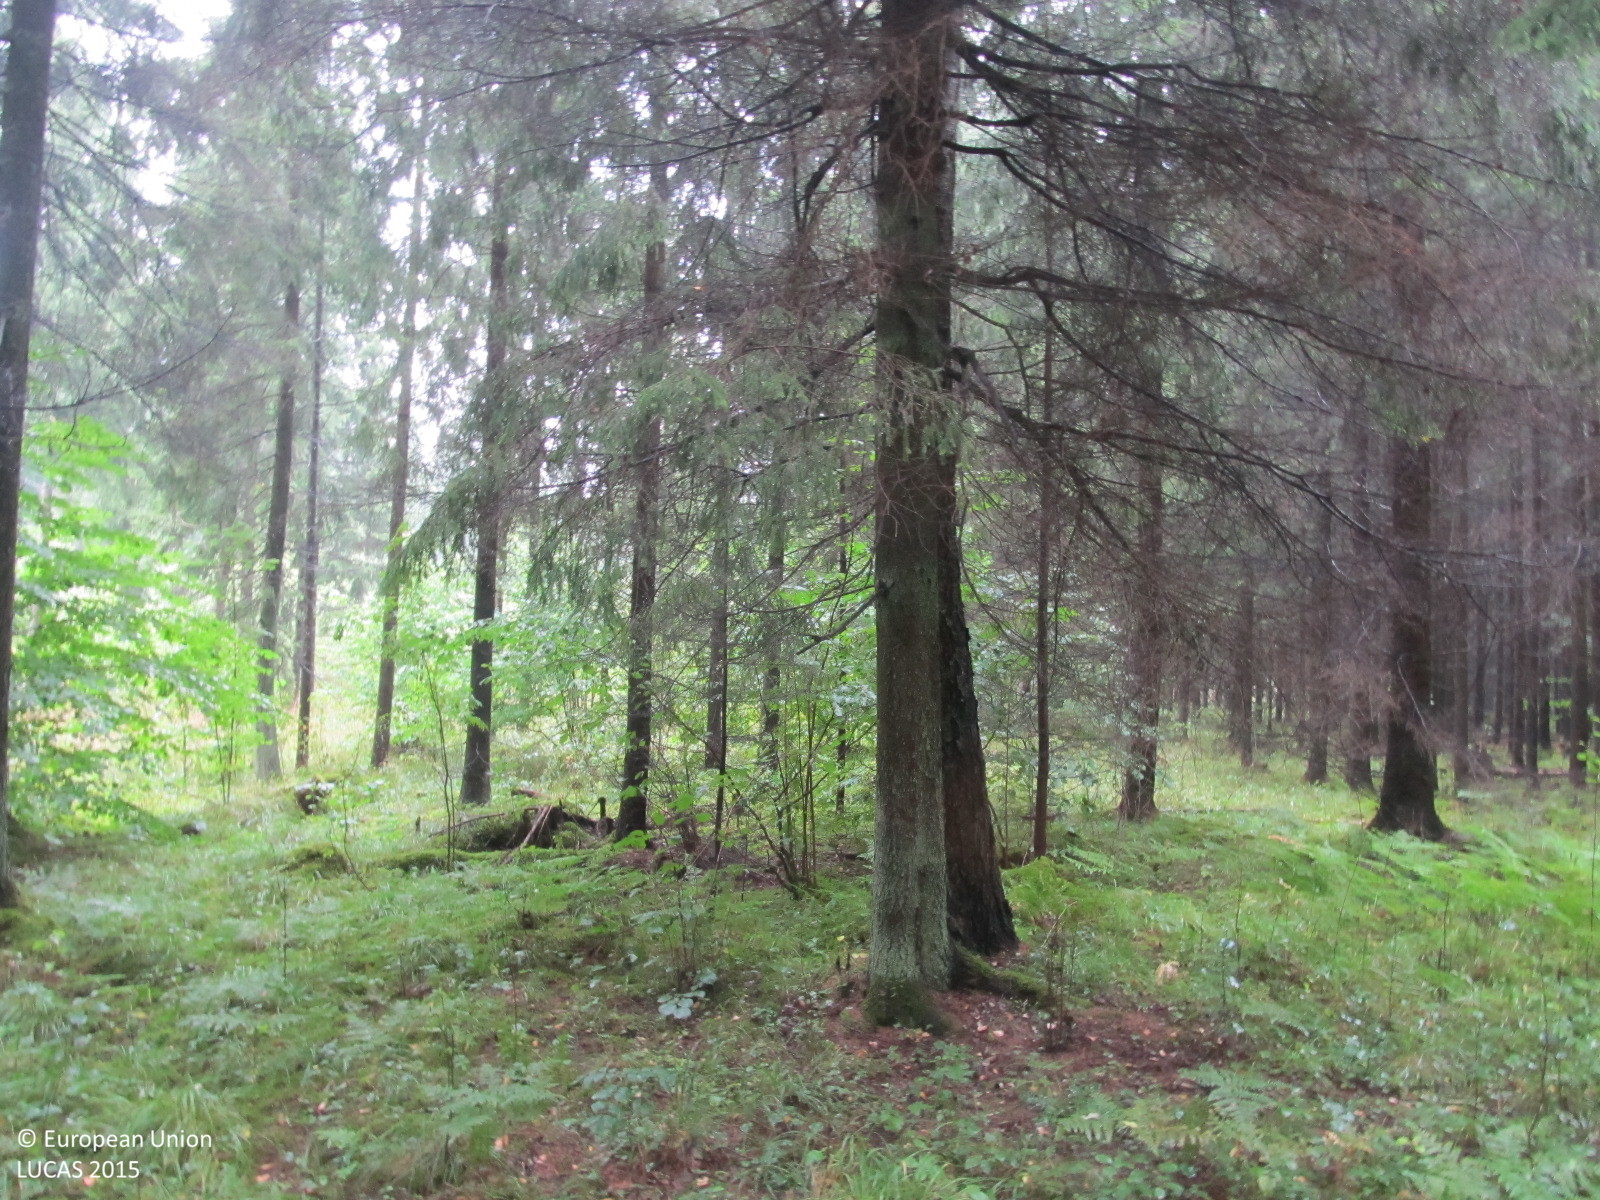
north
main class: Woodland
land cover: Spruce dominated mixed woodland
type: hemiboreal forest and nemoral coniferous forest and mixed broadleaved-coniferous forest
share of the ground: > 75 %
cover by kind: coniferous forest trees 65 %, broadleaved forest trees 30 %, herbaceous plants 5 %
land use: Forestry
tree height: > 5 m
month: September
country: LT
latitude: 56.0538
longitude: 23.1570
